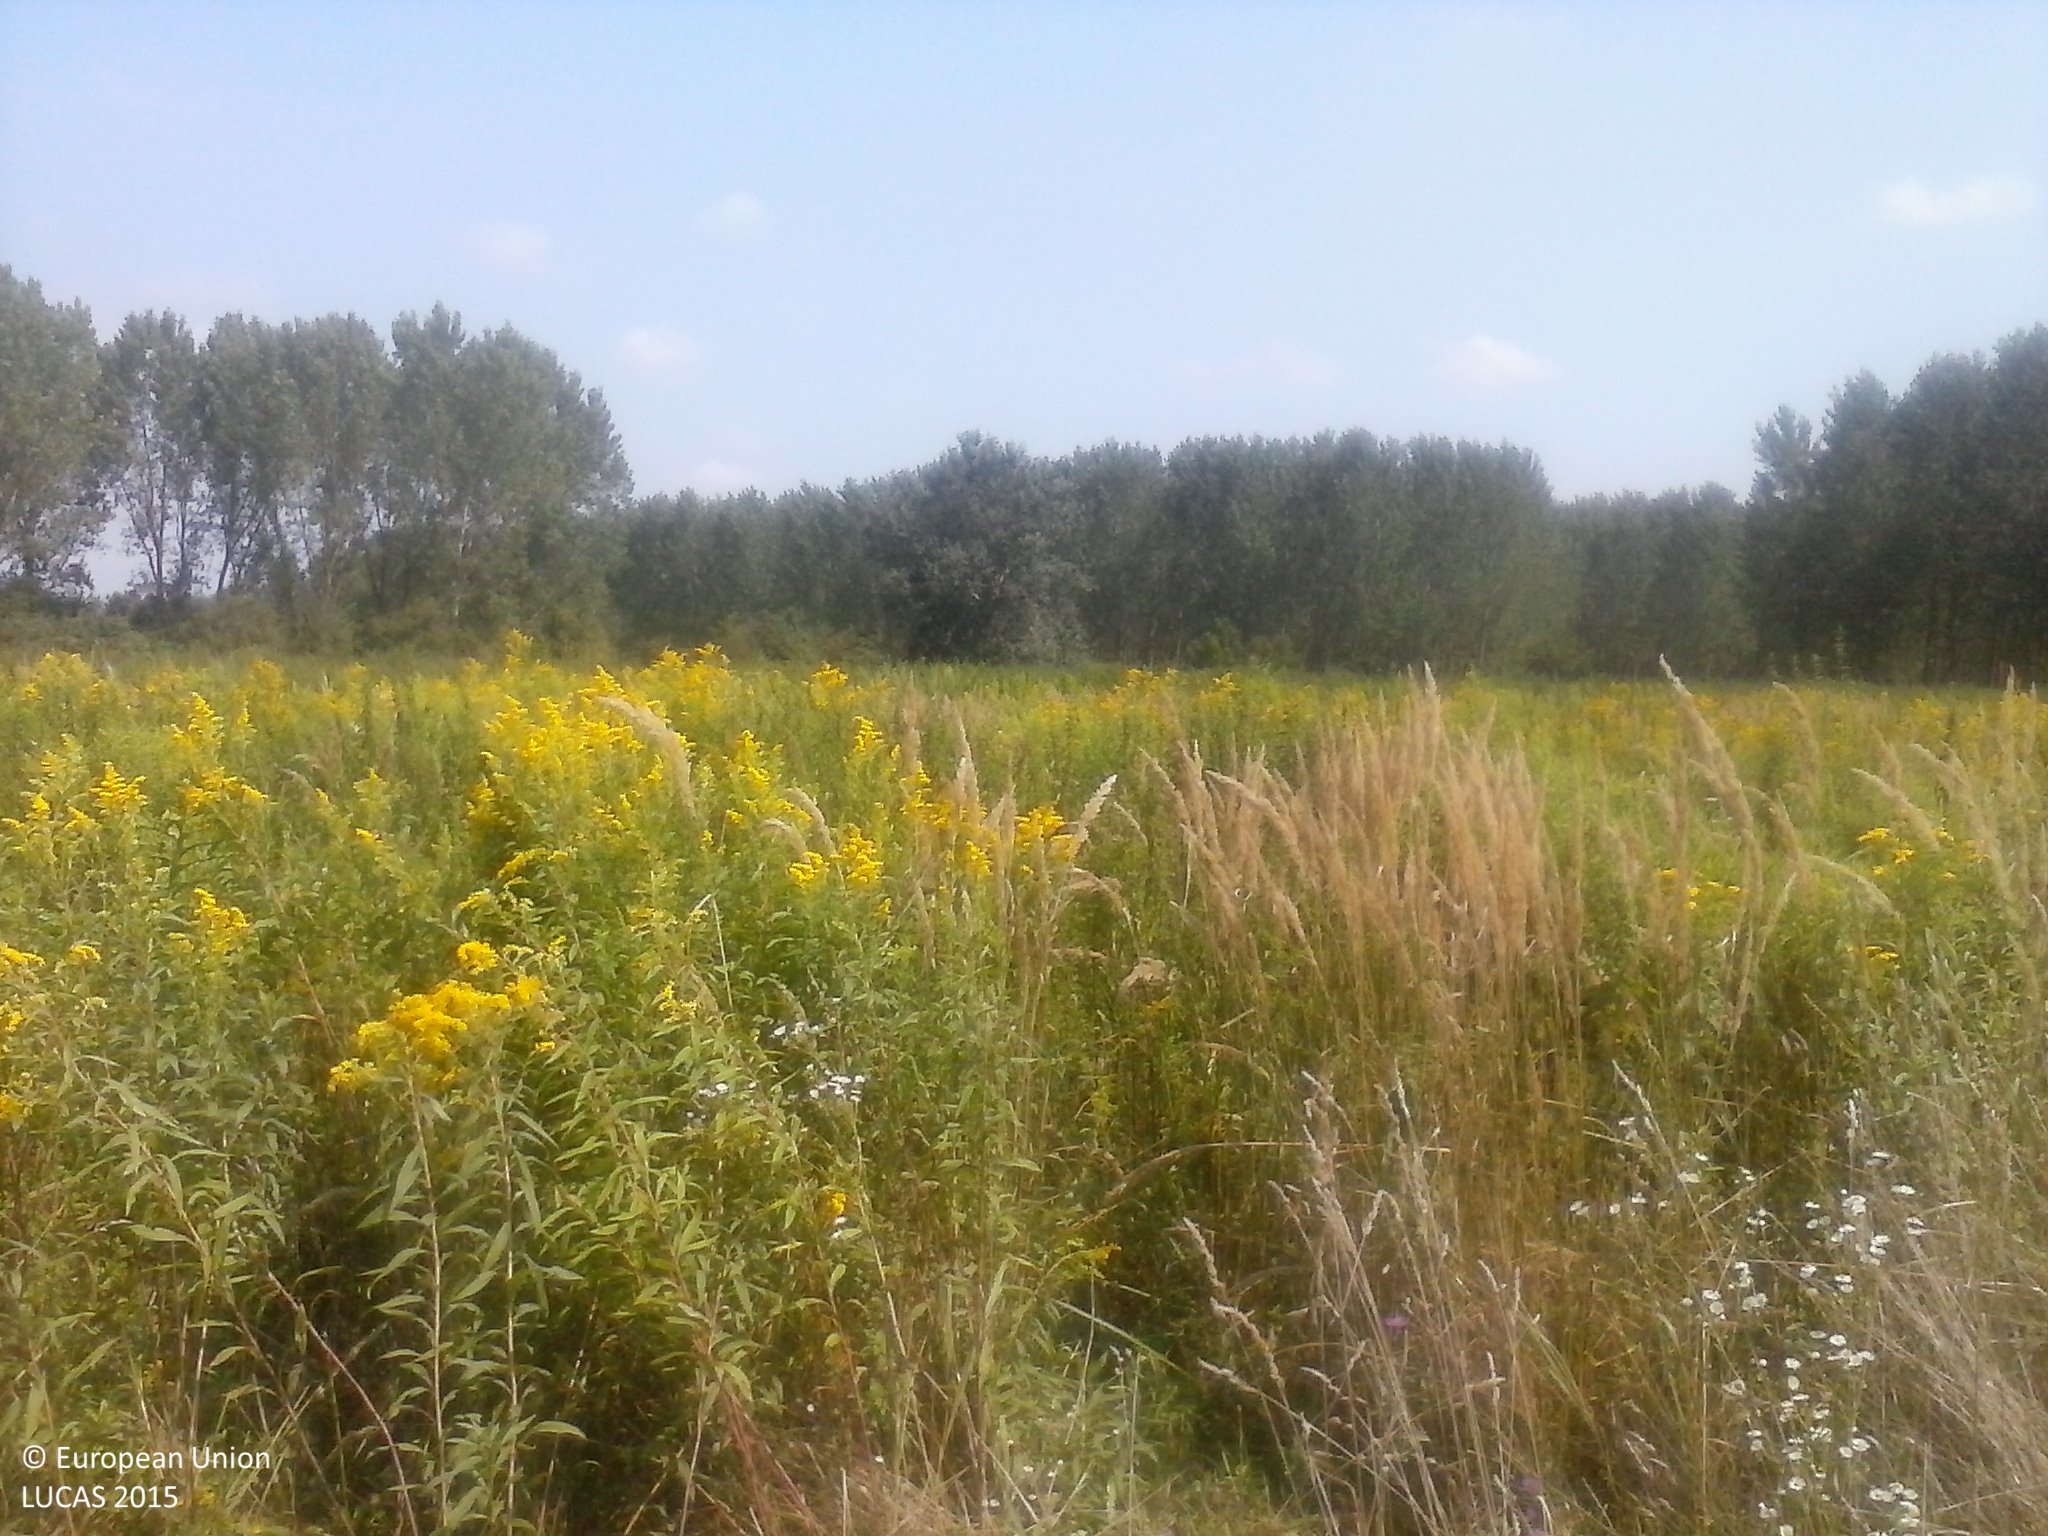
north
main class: Grassland
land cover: Grassland without tree/shrub cover
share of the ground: > 75 %
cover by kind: herbaceous plants 100 %
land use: Agriculture (excluding fallow land and kitchen gardens)
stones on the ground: < 10 %
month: August
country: HU
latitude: 45.8870
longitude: 17.7745
